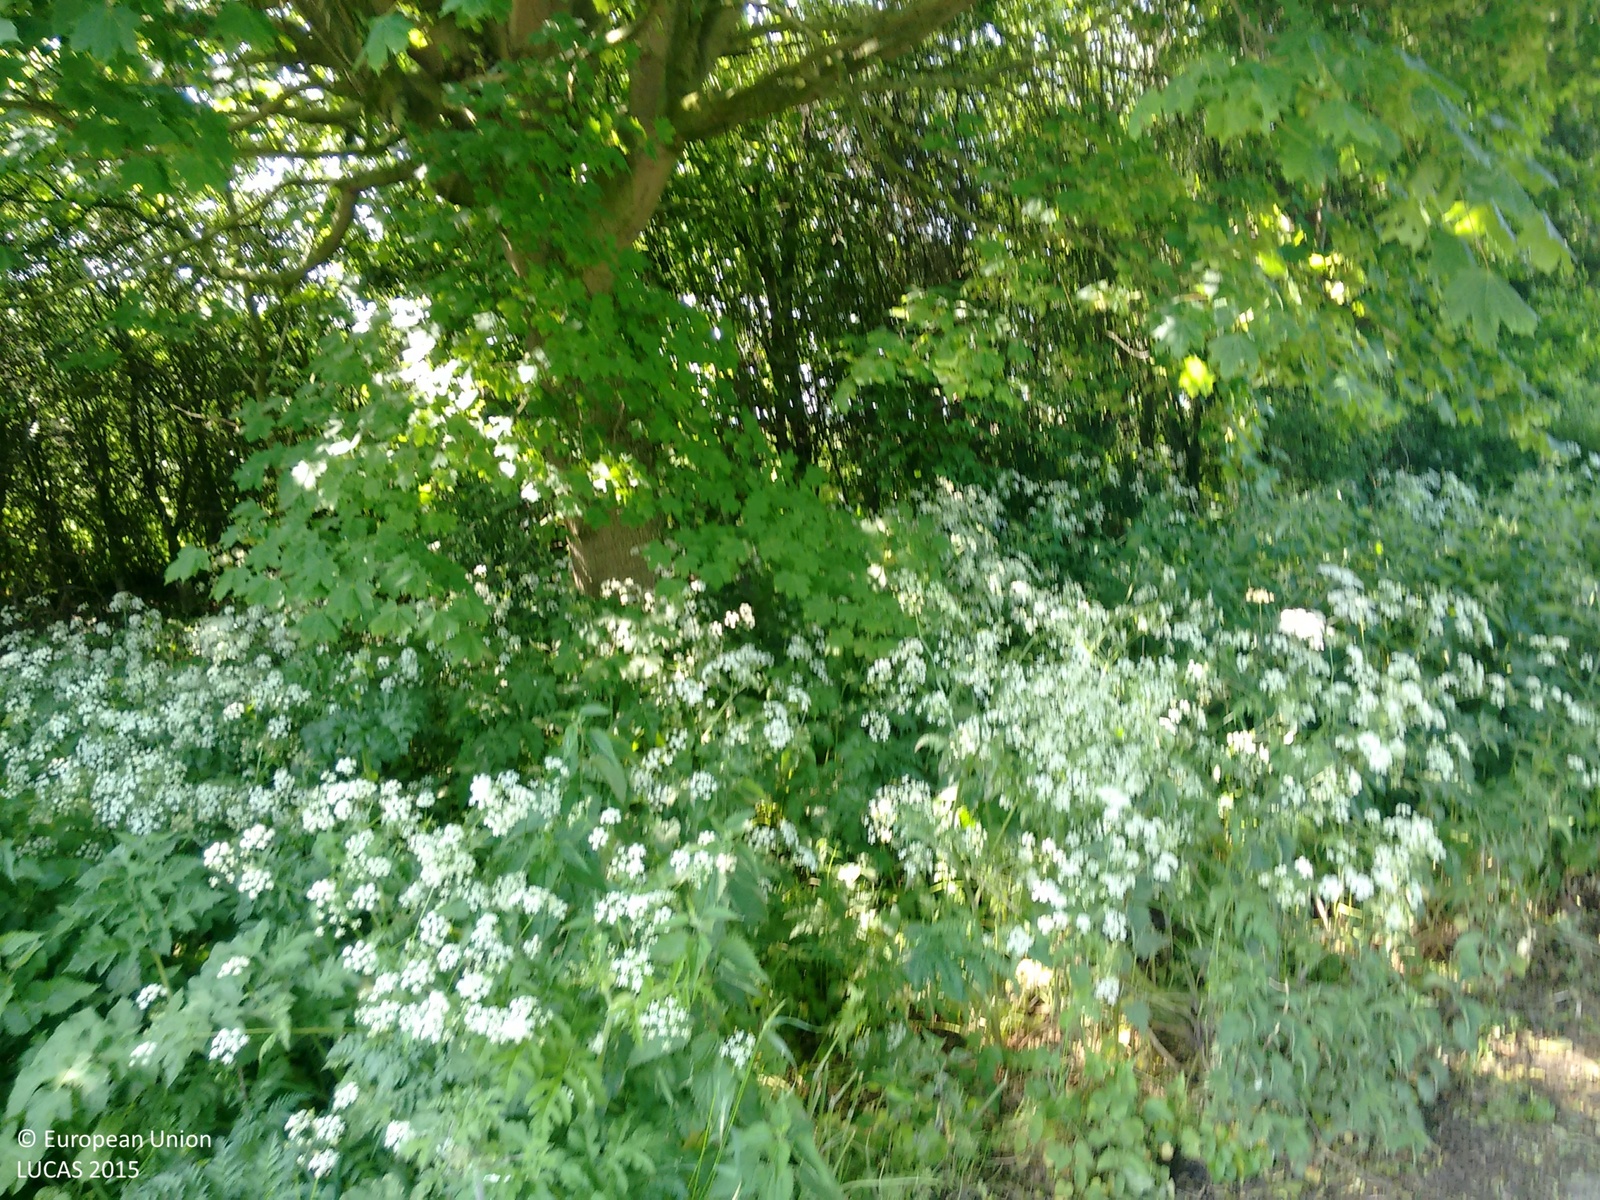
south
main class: Woodland
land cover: Broadleaved woodland
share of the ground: > 75 %
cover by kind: broadleaved forest trees 100 %
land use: Semi-natural and natural areas not in use
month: June
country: GB
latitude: 53.9533
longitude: -1.1845
